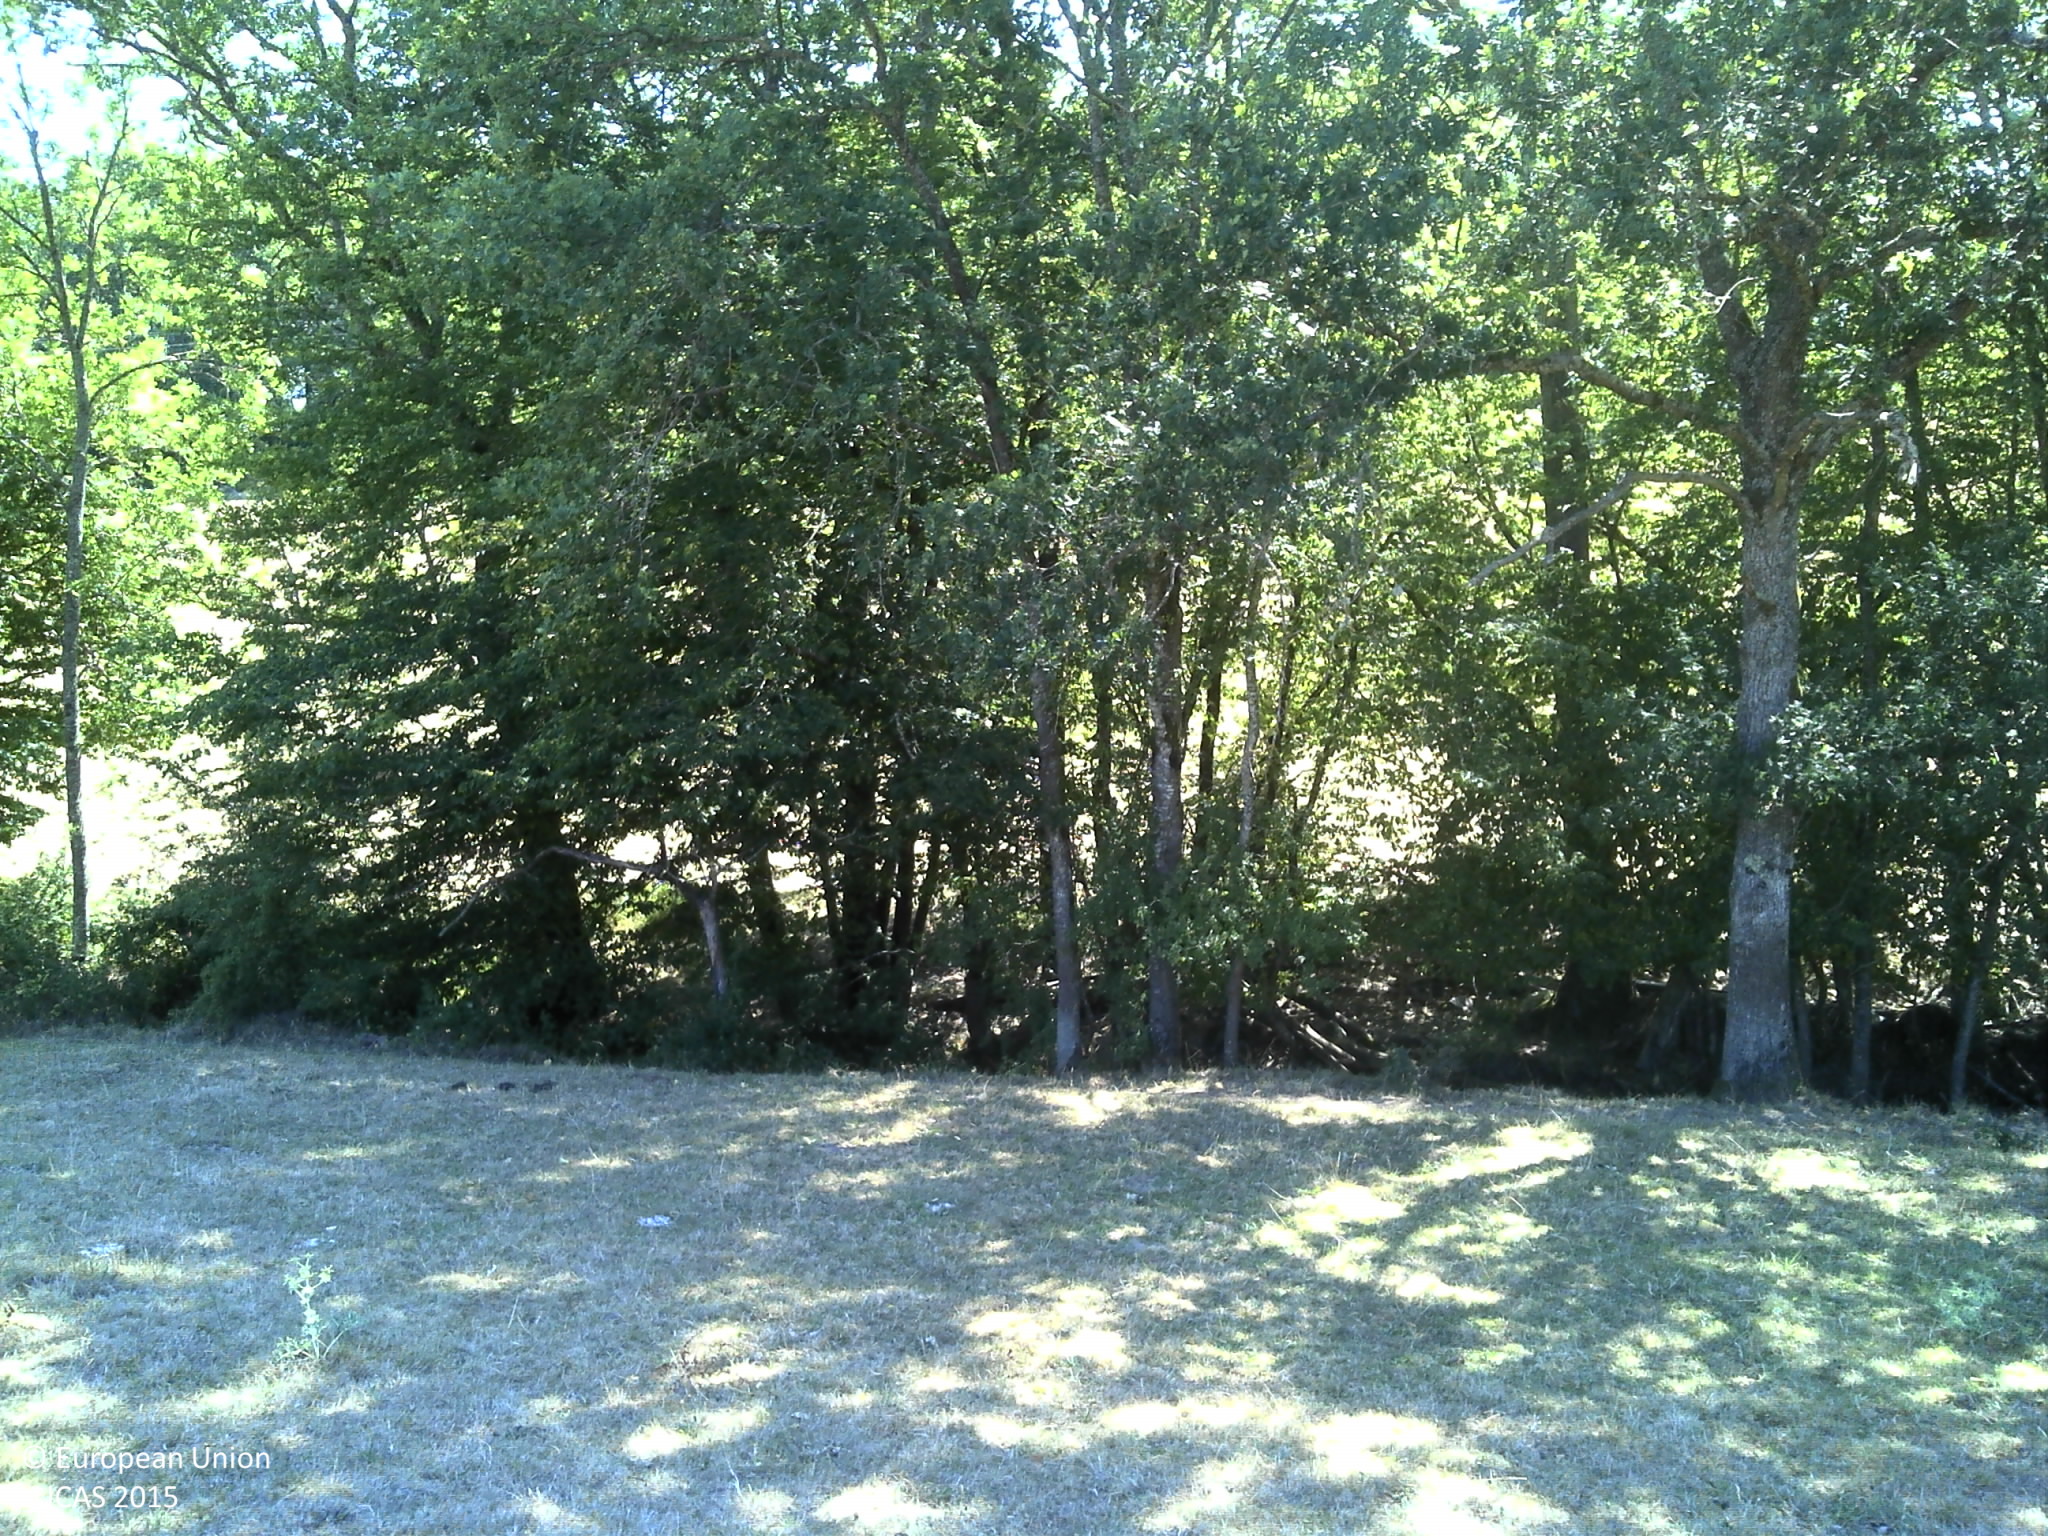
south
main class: Grassland
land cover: Grassland without tree/shrub cover
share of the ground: > 75 %
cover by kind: herbaceous plants 100 %
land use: Agriculture (excluding fallow land and kitchen gardens)
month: July
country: FR
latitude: 45.8792
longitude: 4.0623
